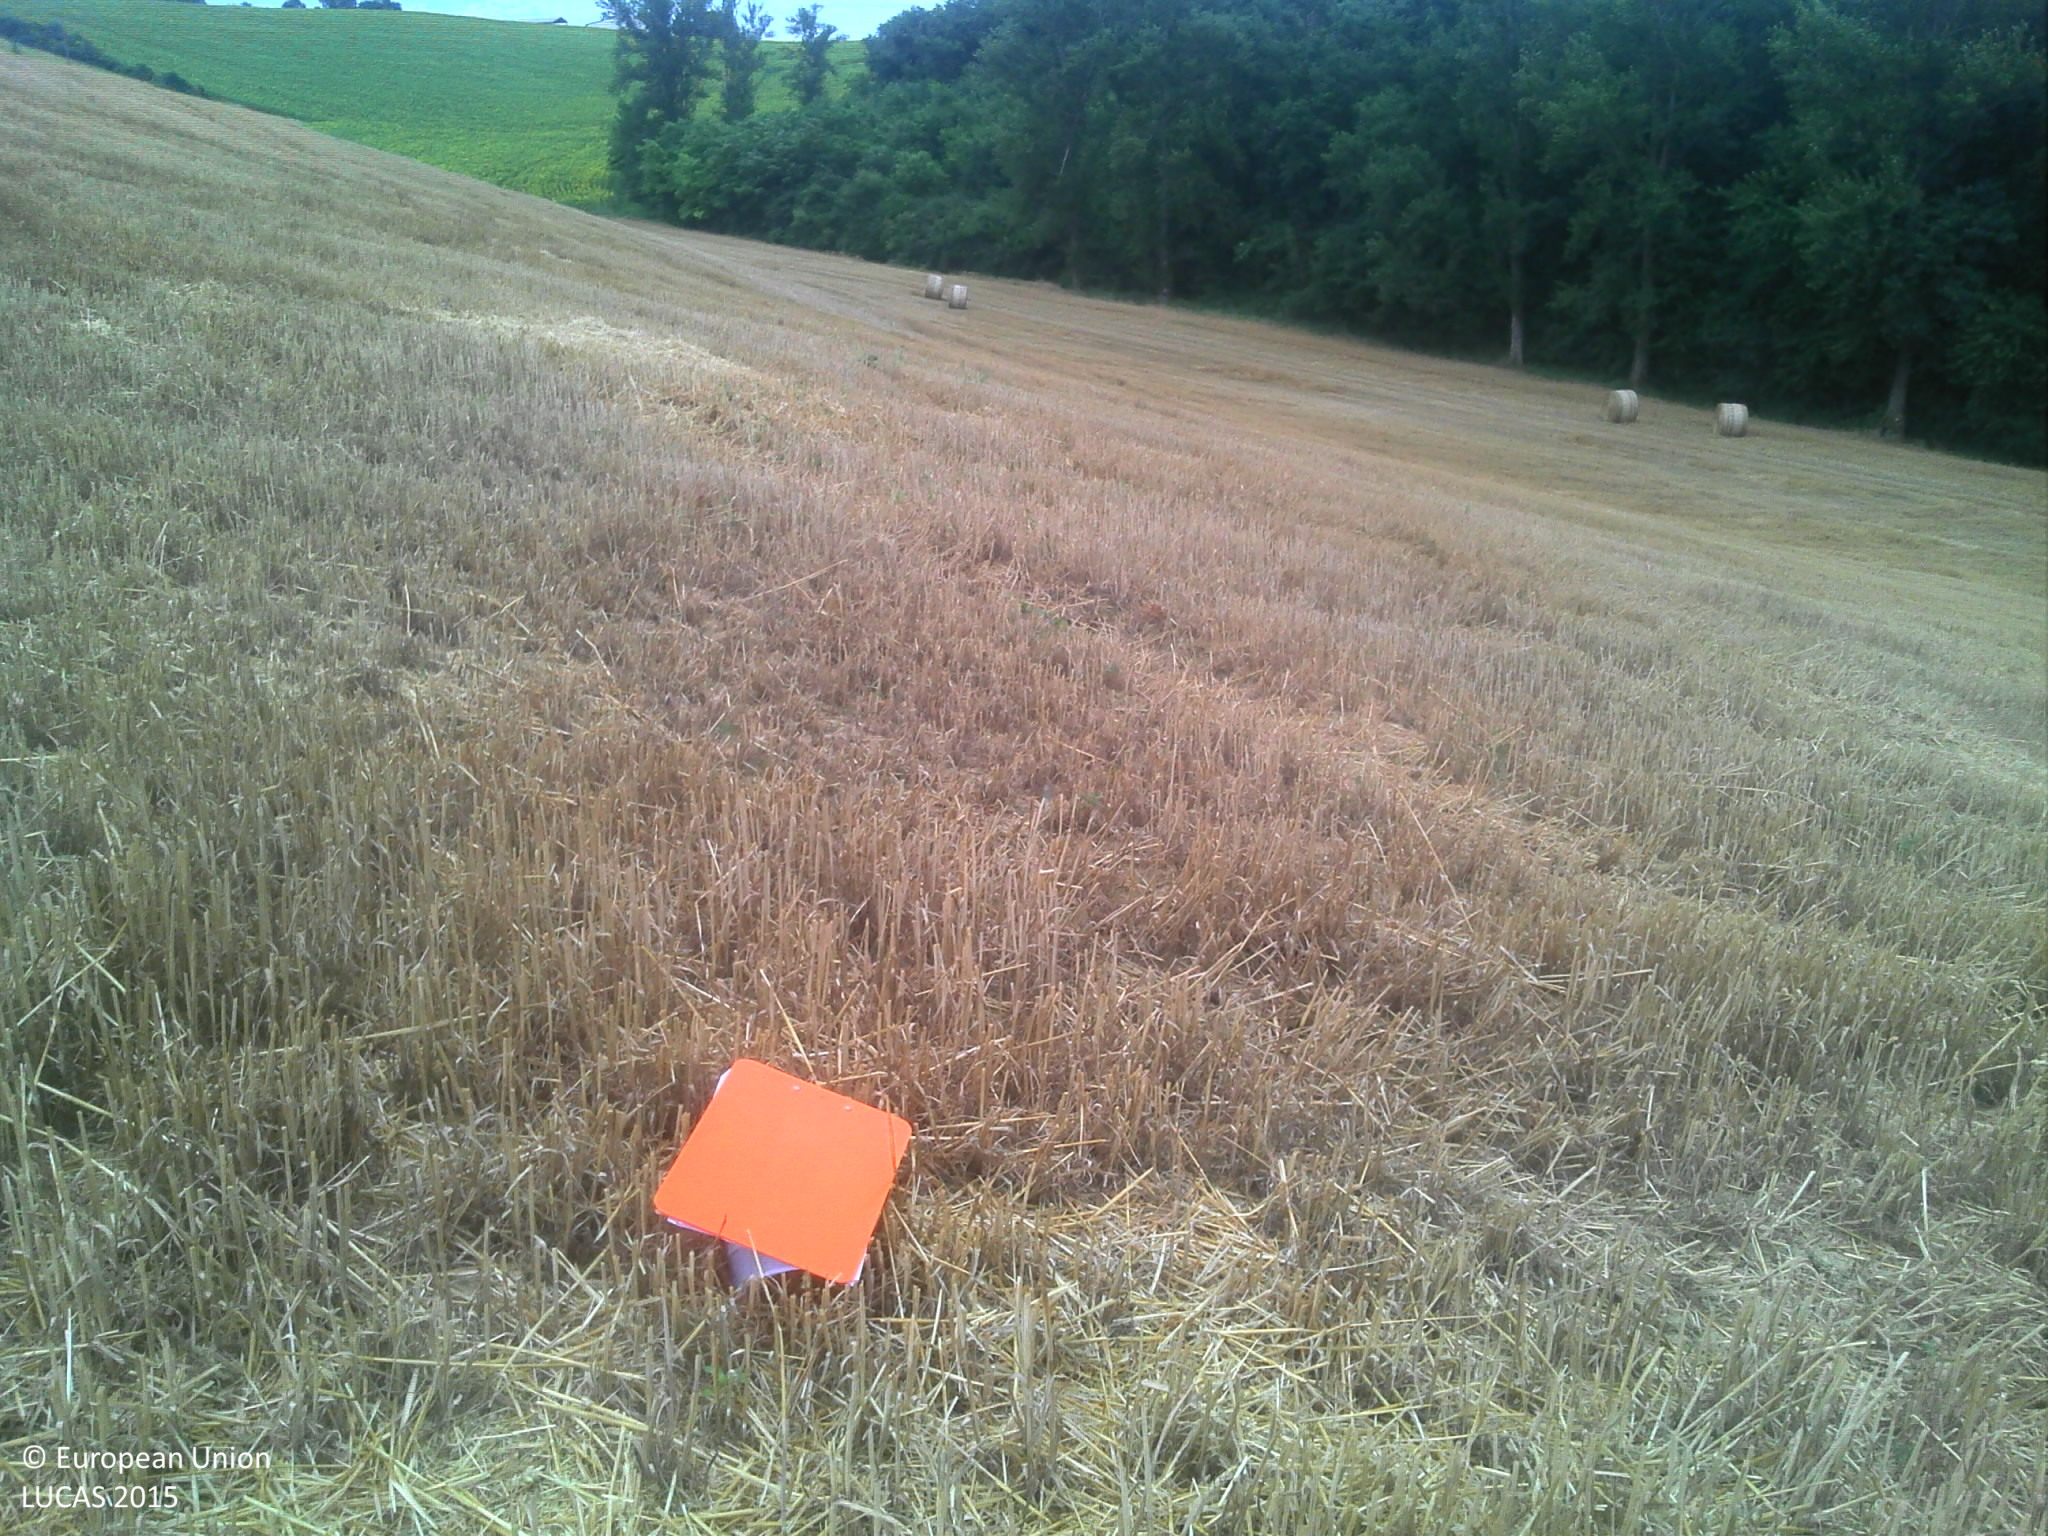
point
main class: Cropland
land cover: Common wheat
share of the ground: > 75 %
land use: Agriculture (excluding fallow land and kitchen gardens)
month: July
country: FR
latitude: 43.2849
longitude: 1.3898
